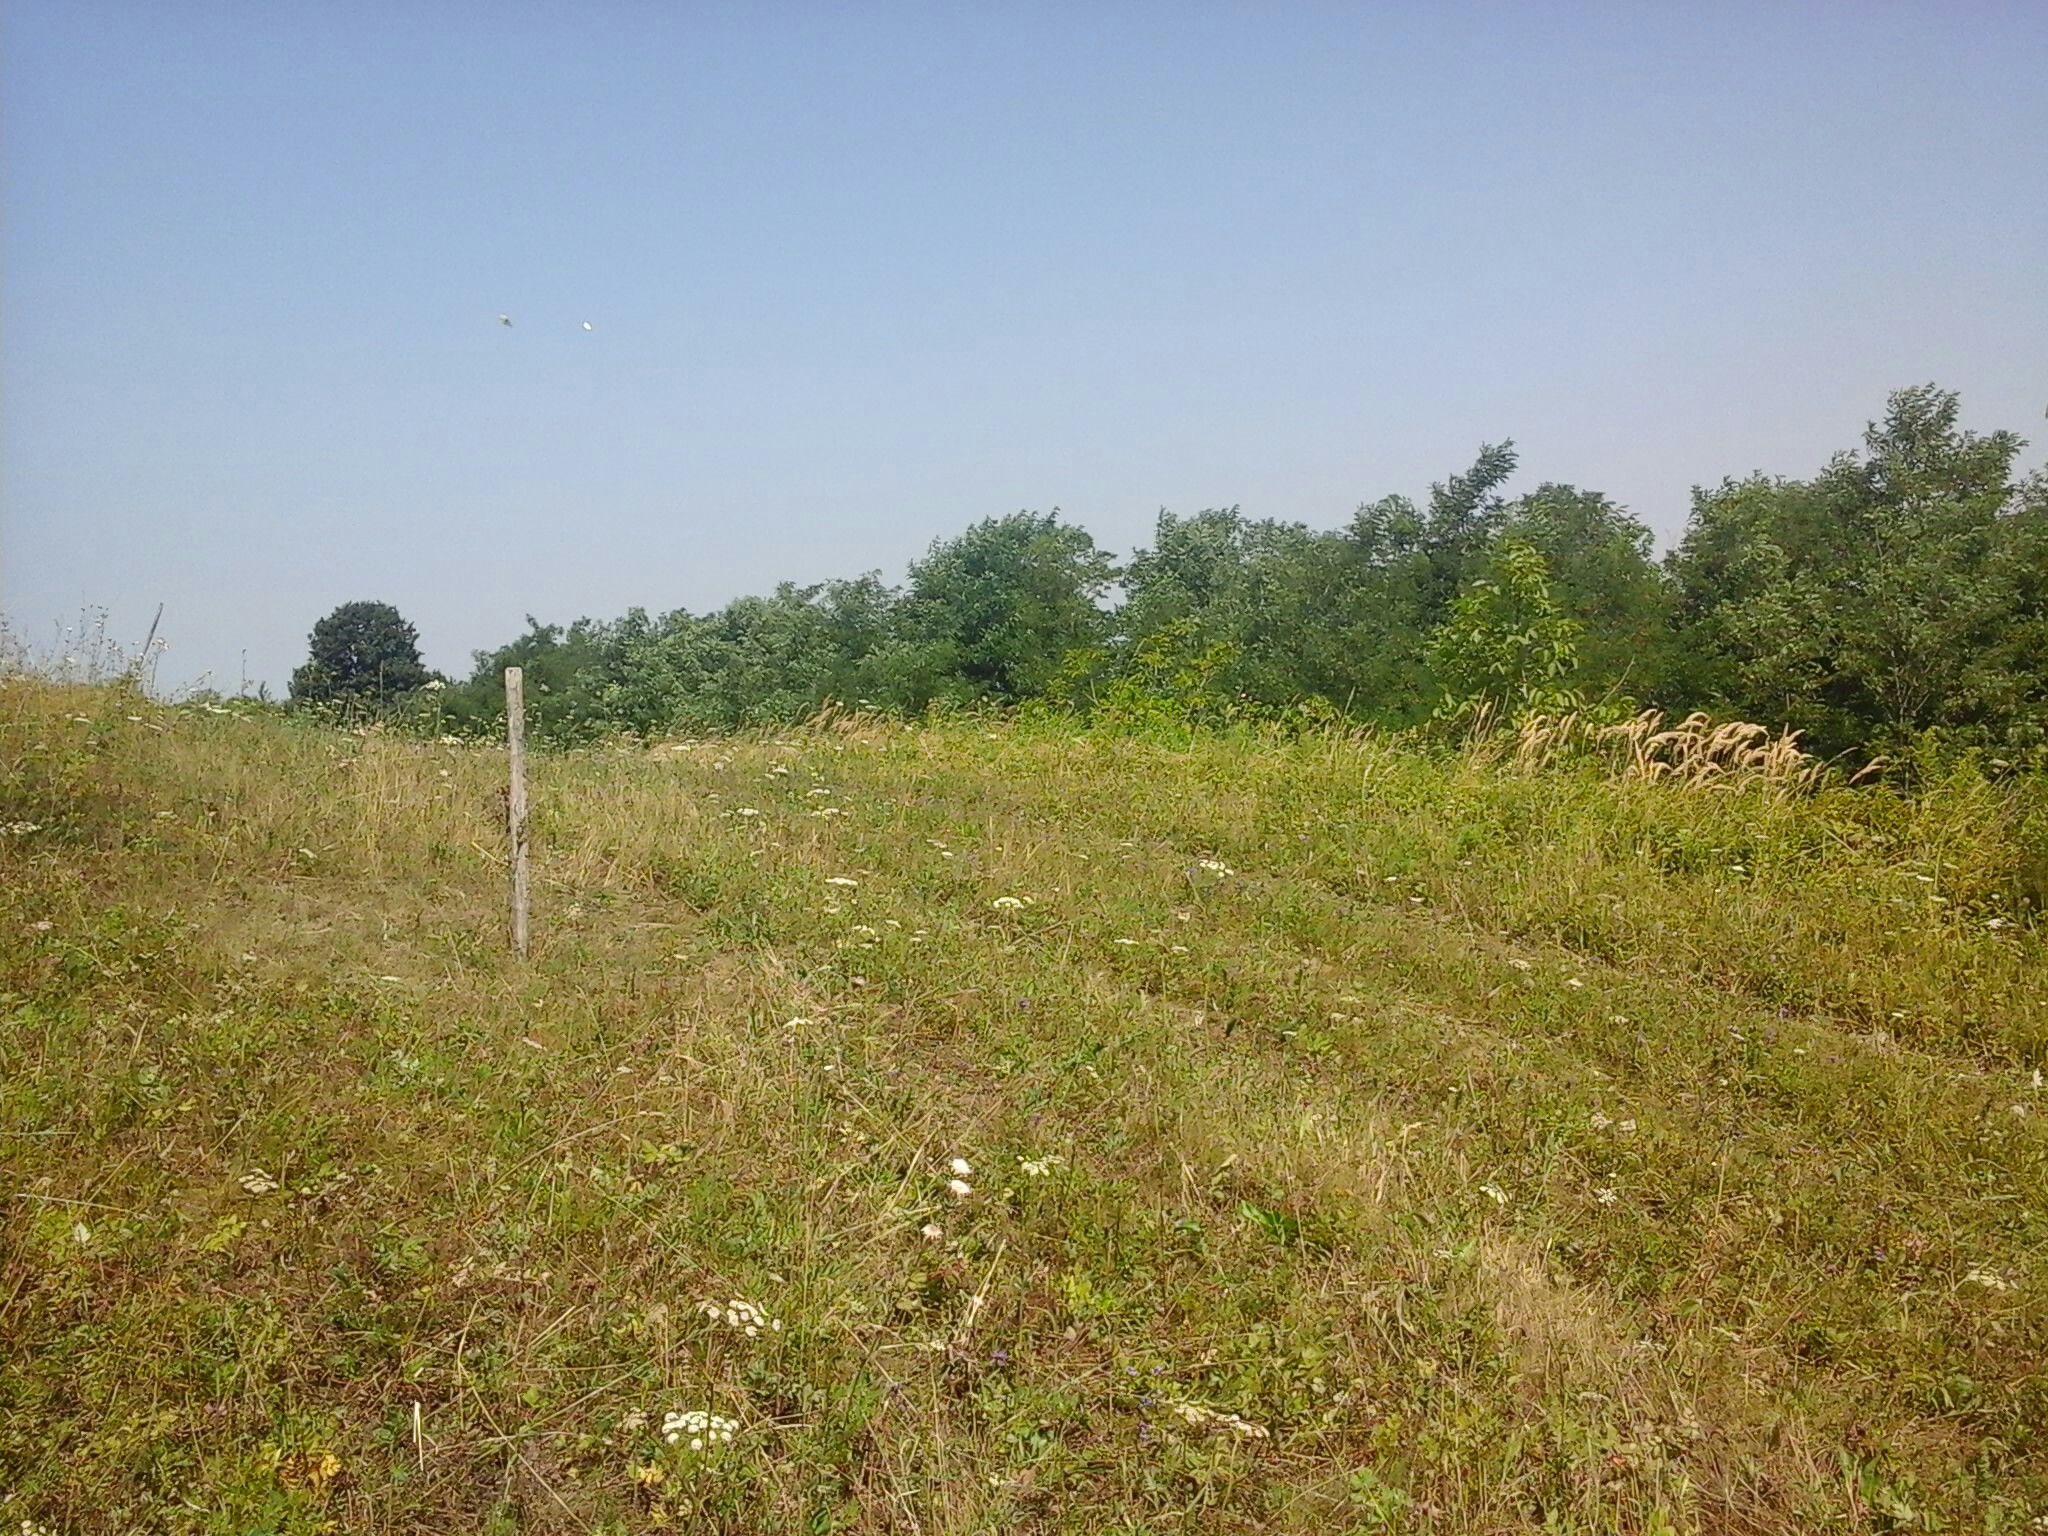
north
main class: Grassland
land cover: Grassland with sparse tree/shrub cover
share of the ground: > 75 %
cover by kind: herbaceous plants 85 %, shrubs 10 %, broadleaved forest trees 5 %
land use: Fallow land
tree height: > 5 m
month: August
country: HU
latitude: 47.4080
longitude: 18.0015
